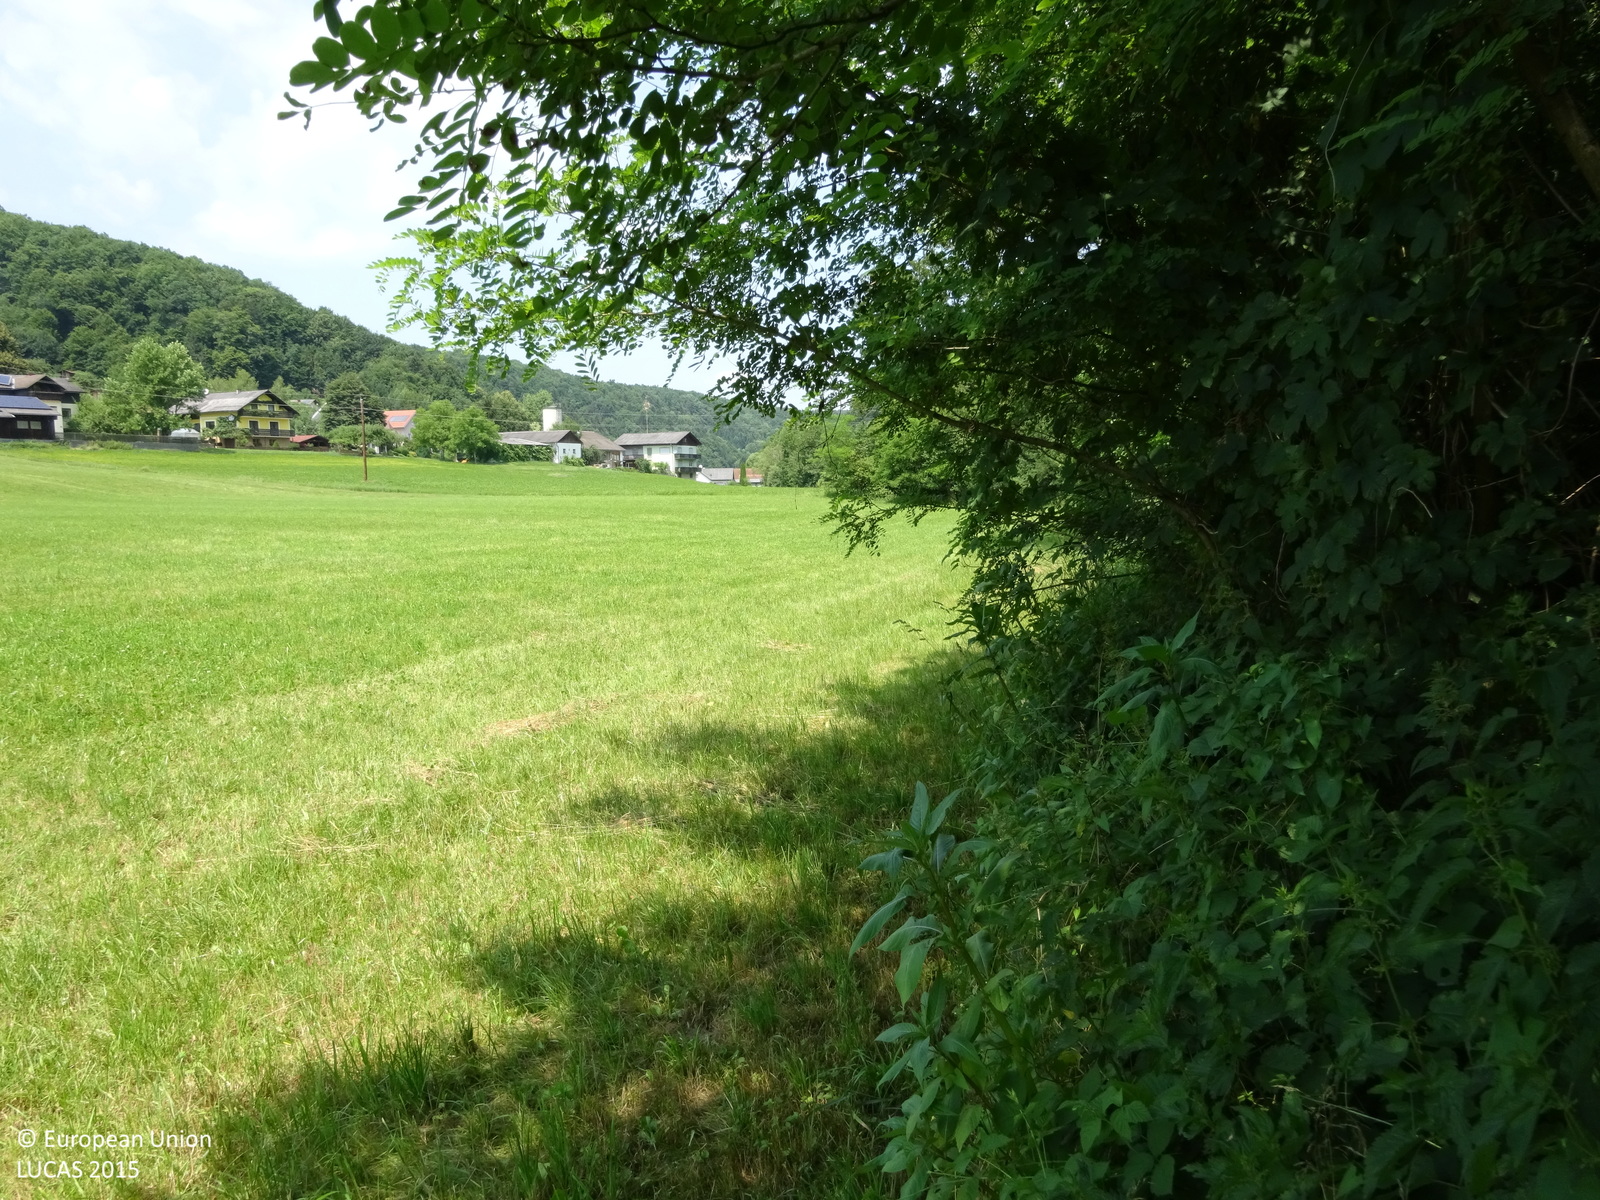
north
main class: Woodland
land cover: Broadleaved woodland
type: floodplain forest
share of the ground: 25 - 50 %
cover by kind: broadleaved forest trees 50 %, shrubs 50 %
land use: Forestry
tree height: > 5 m
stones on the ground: 10 - 25 %
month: July
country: AT
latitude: 46.9258
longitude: 15.9500
